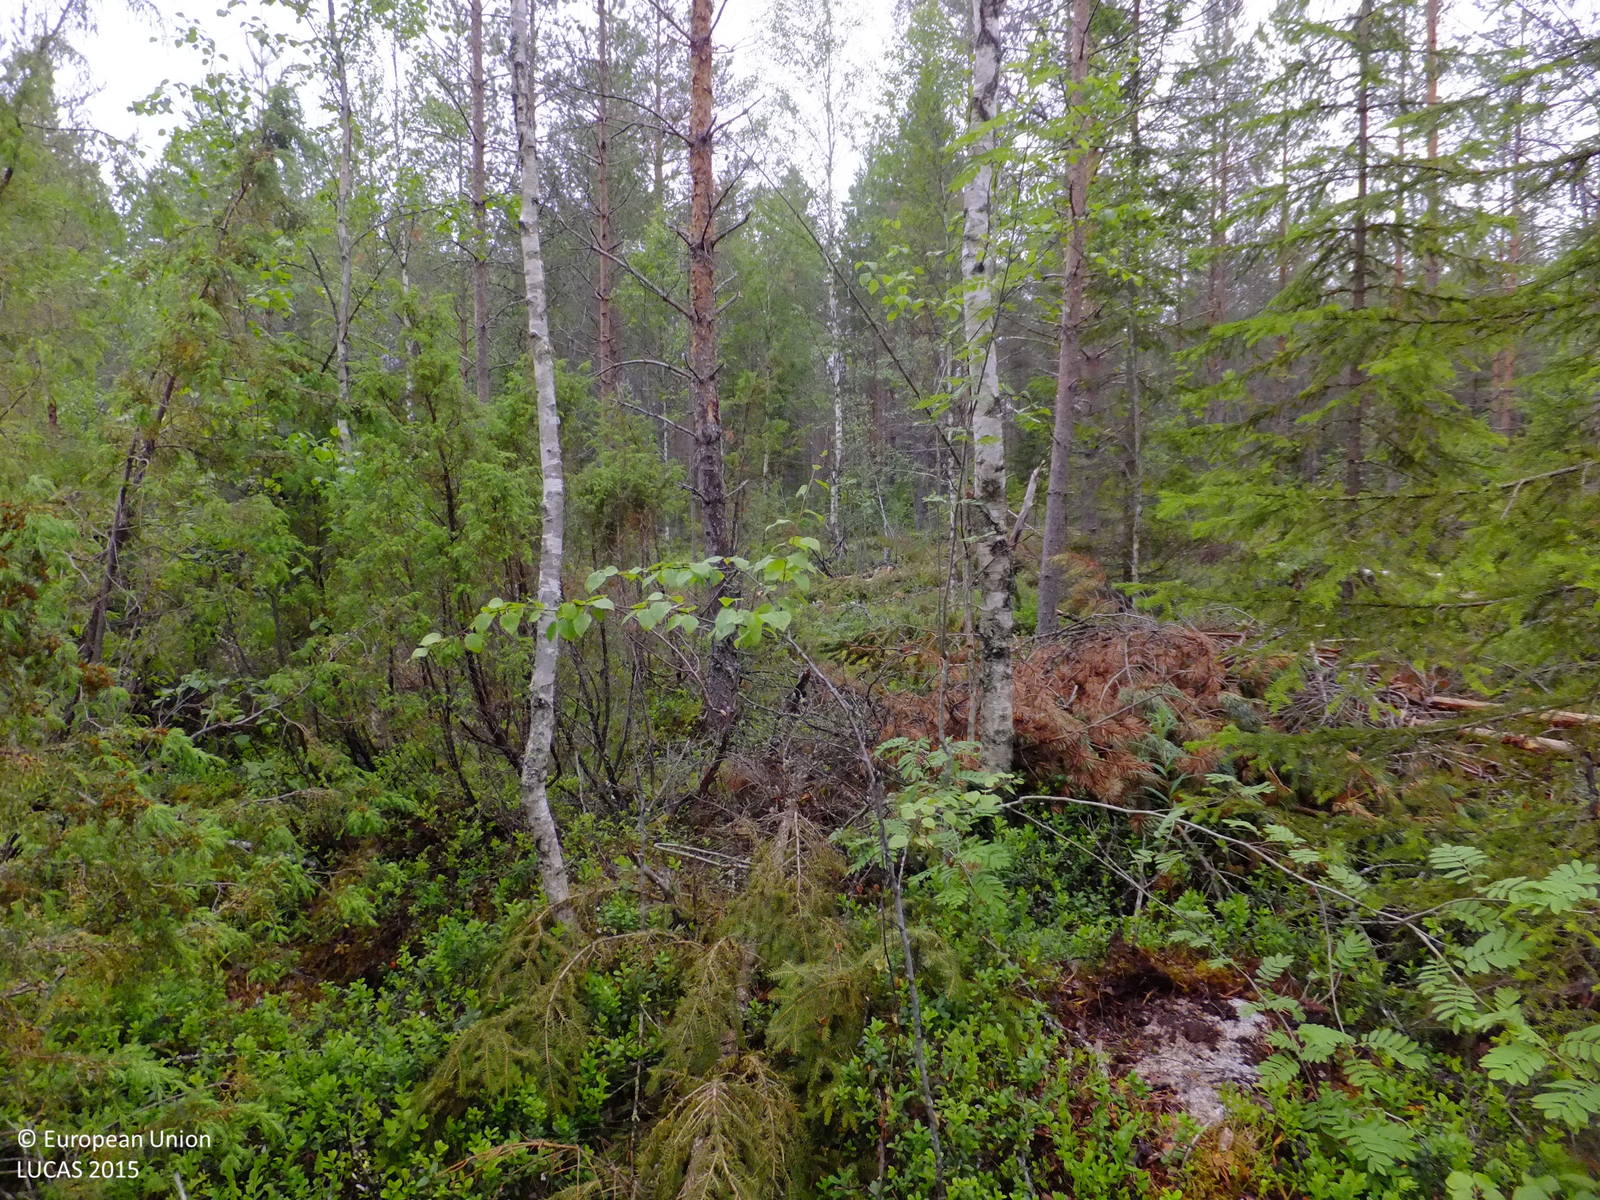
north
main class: Woodland
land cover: Other coniferous woodland
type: boreal forest
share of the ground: > 75 %
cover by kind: coniferous forest trees 70 %, broadleaved forest trees 10 %, shrubs 10 %, herbaceous plants 5 %, lichens and mosses 5 %
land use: Forestry
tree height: > 5 m
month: July
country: FI
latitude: 63.1689
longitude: 24.5613
